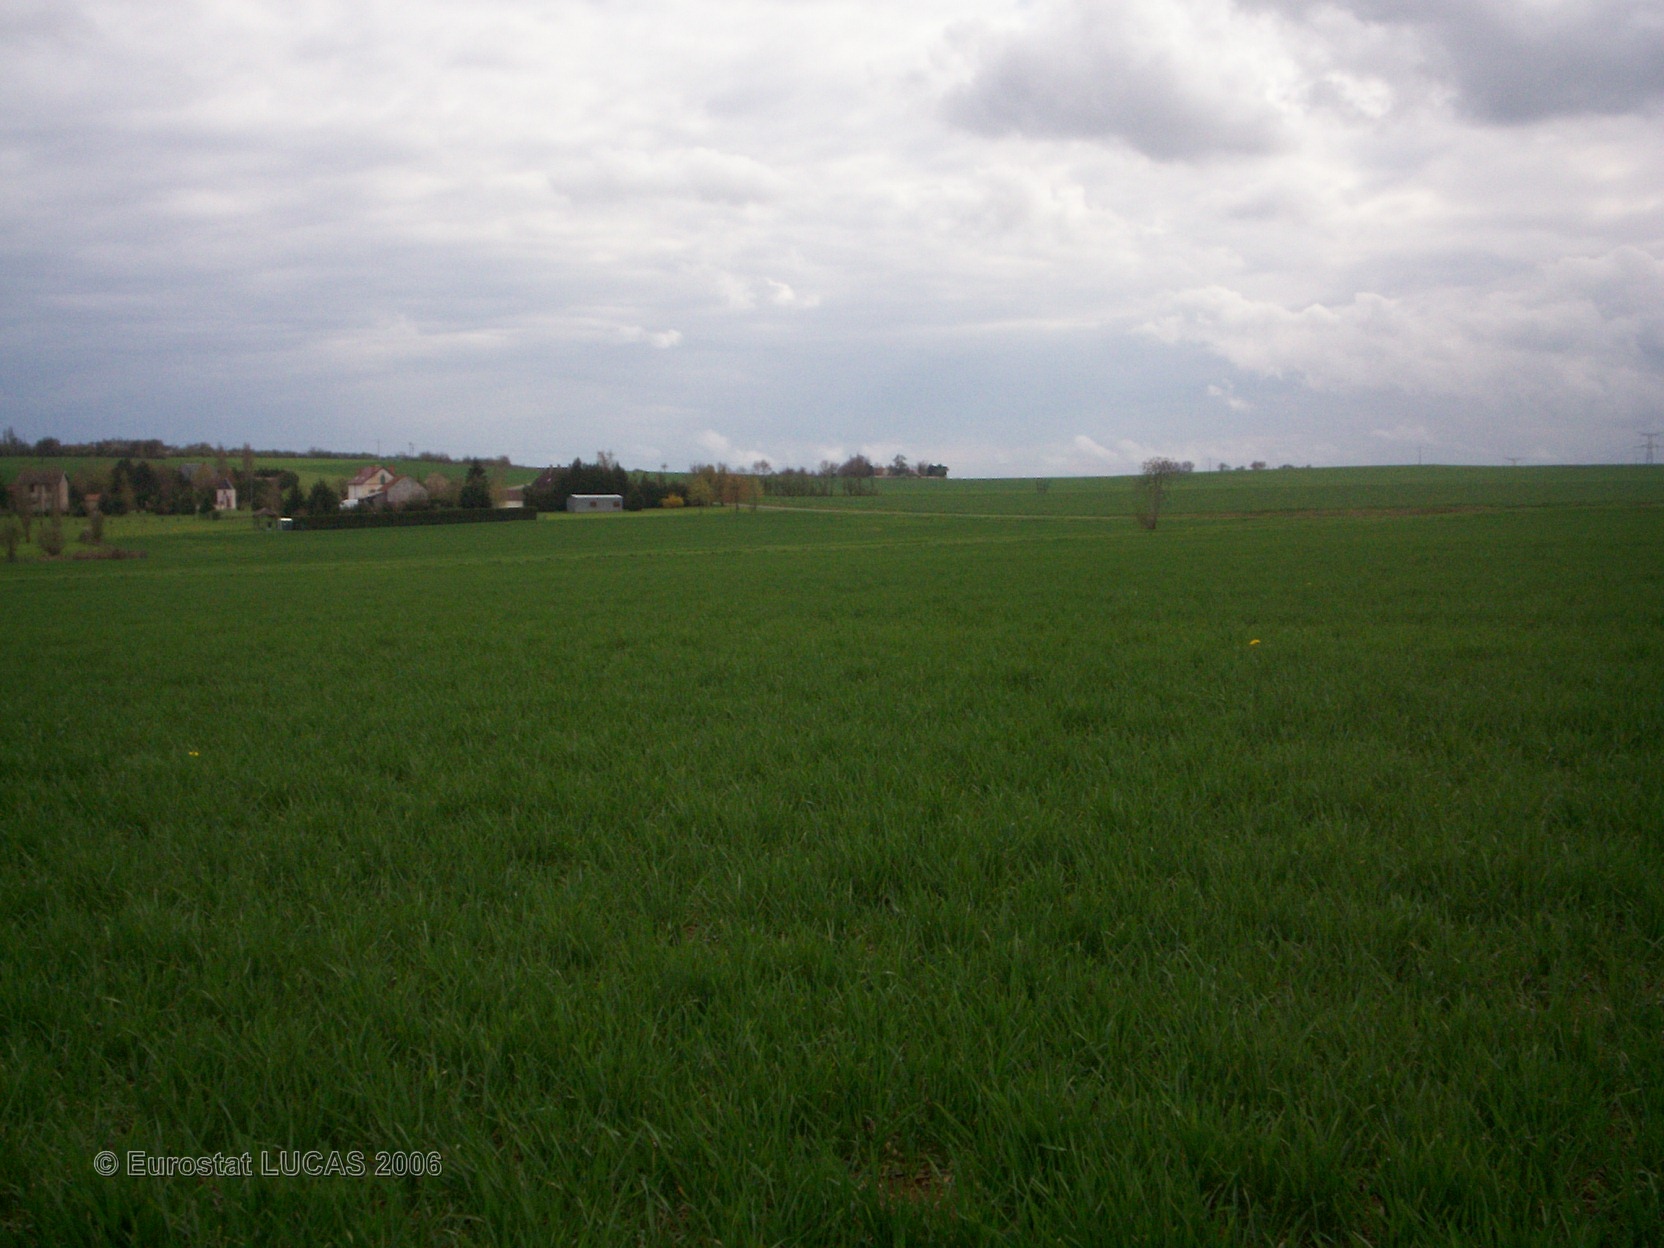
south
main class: Cropland
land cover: Common wheat
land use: Agriculture (excluding fallow land and kitchen gardens)
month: April
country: FR
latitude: 47.4414
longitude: 3.0062
